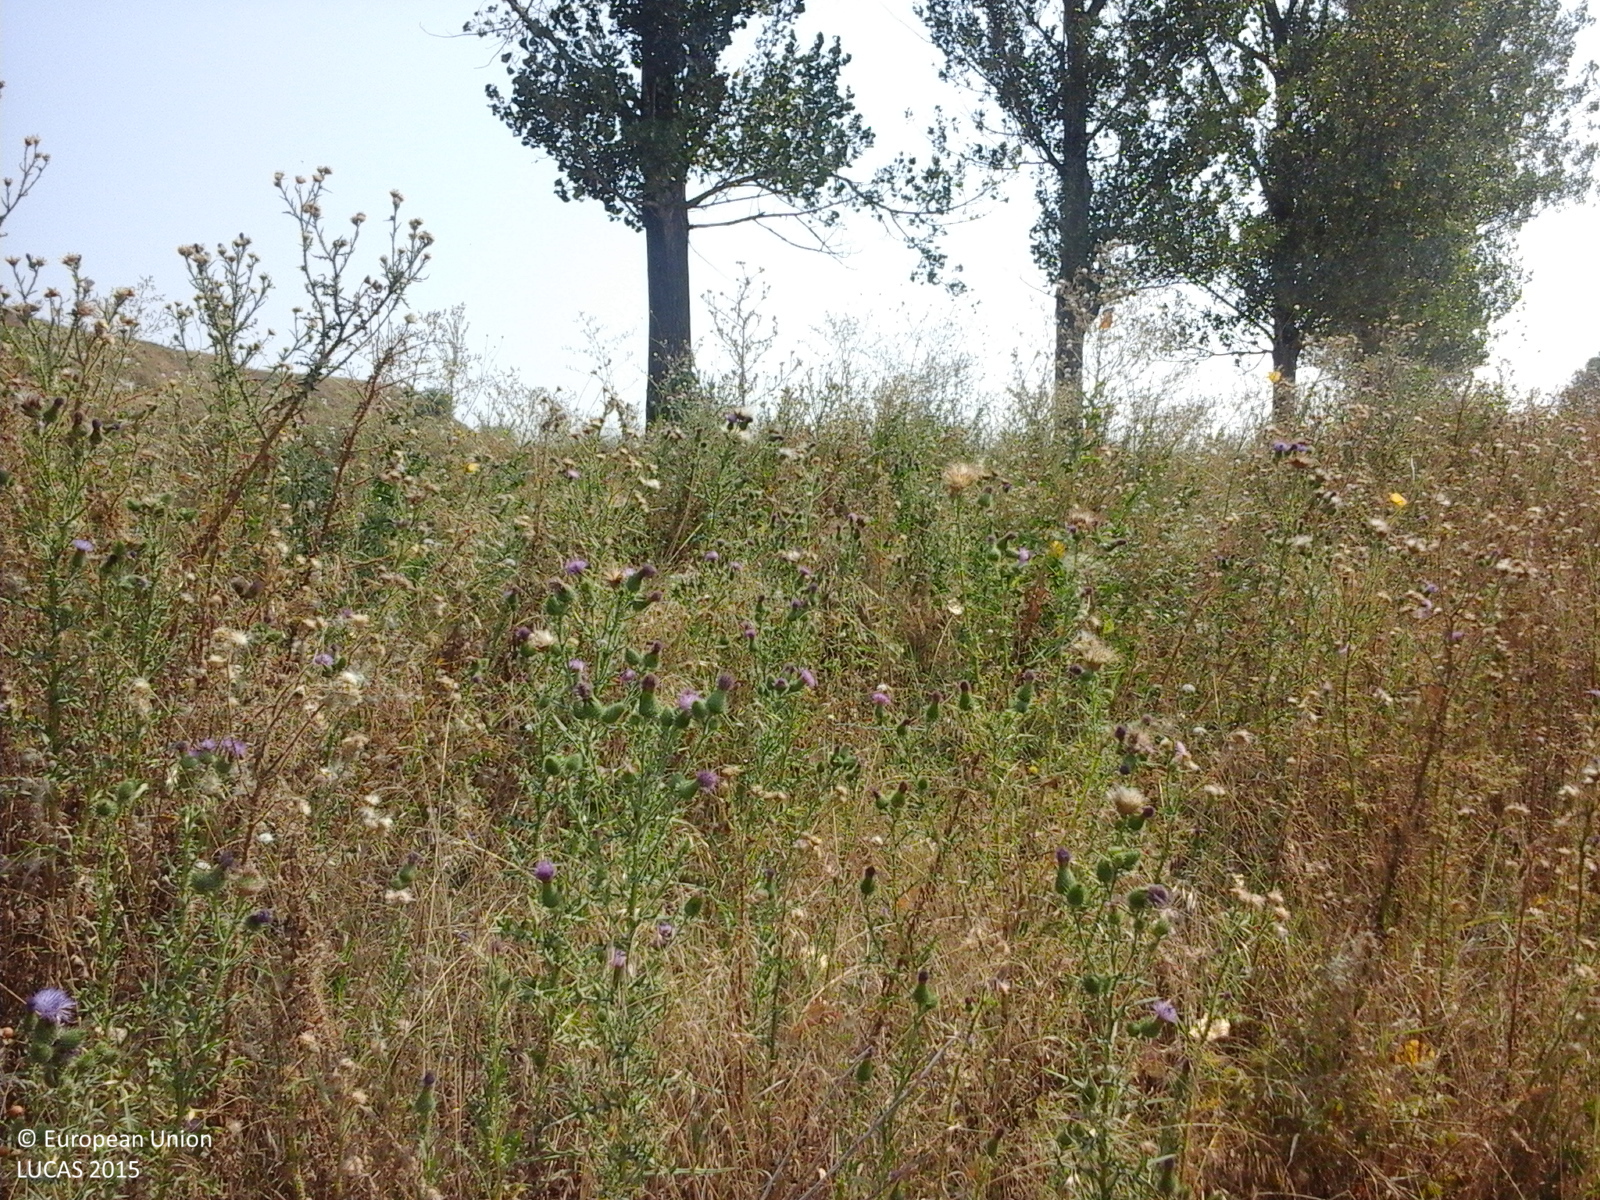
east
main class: Grassland
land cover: Spontaneously vegetated surfaces
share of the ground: > 75 %
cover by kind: herbaceous plants 100 %
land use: Fallow land
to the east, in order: Spontaneously vegetated surfaces; Paved roads, cycling and walking lanes; Grass margins; Ditches and canals; Grassland without tree/shrub cover; Lines of trees; Grassland without tree/shrub cover; Spontaneously vegetated surfaces
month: August
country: RO
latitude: 44.3842
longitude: 23.4446
